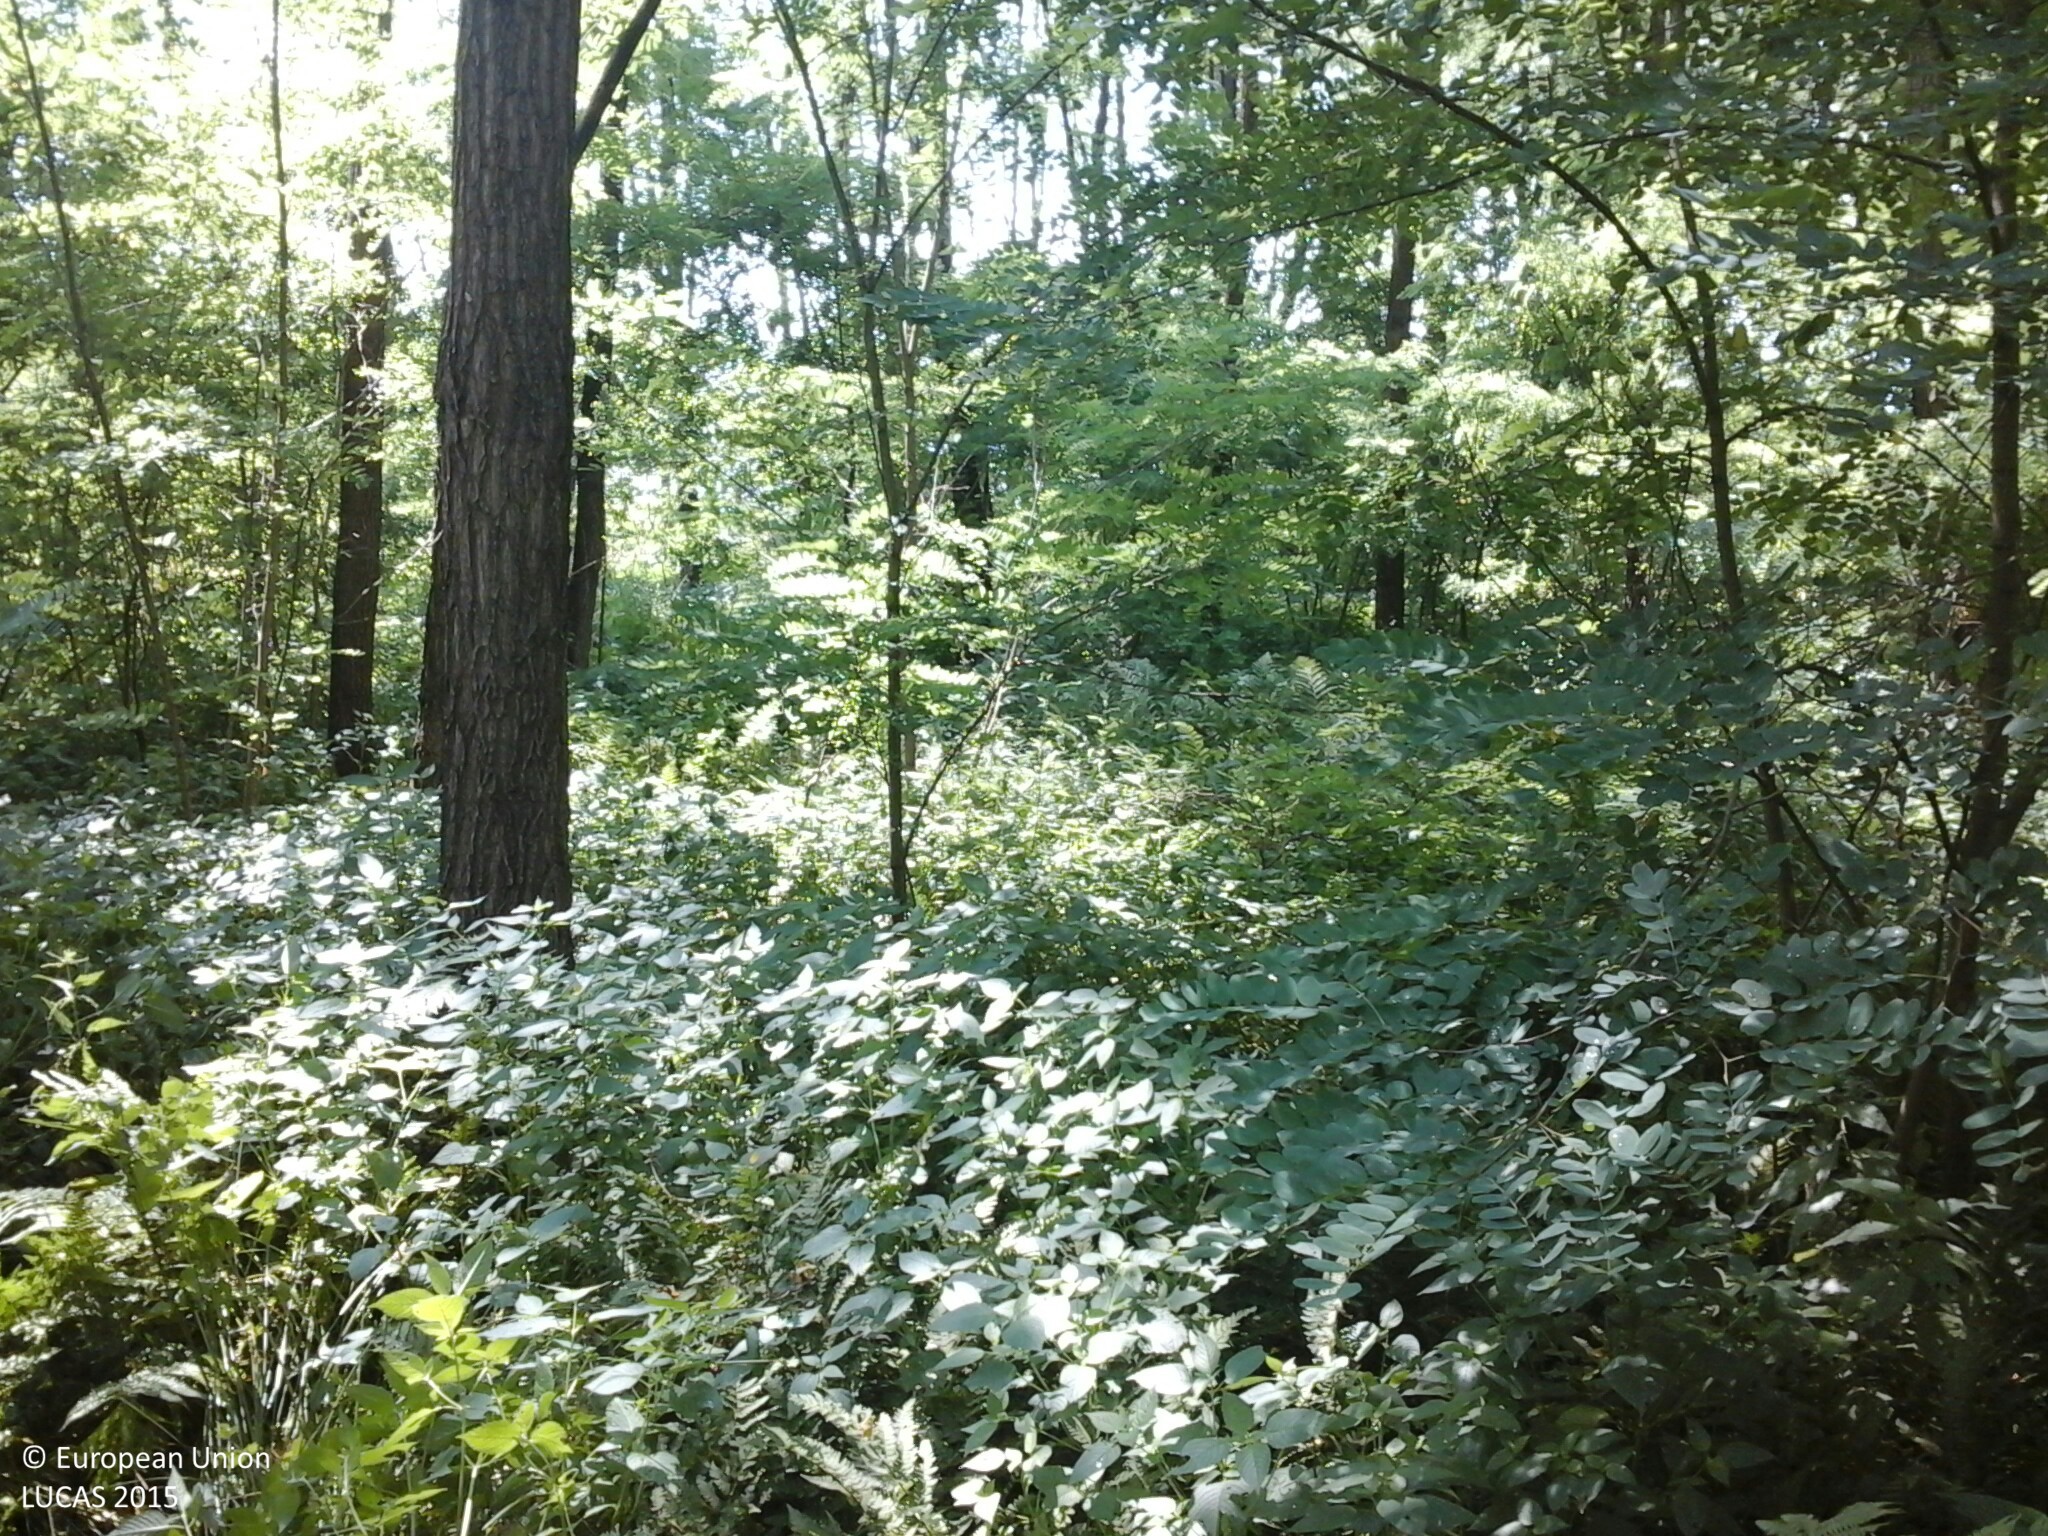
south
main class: Woodland
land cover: Broadleaved woodland
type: mesophytic deciduous forest
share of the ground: > 75 %
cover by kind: broadleaved forest trees 100 %
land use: Forestry
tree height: > 5 m
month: July
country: HU
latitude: 48.3068
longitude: 22.2041
